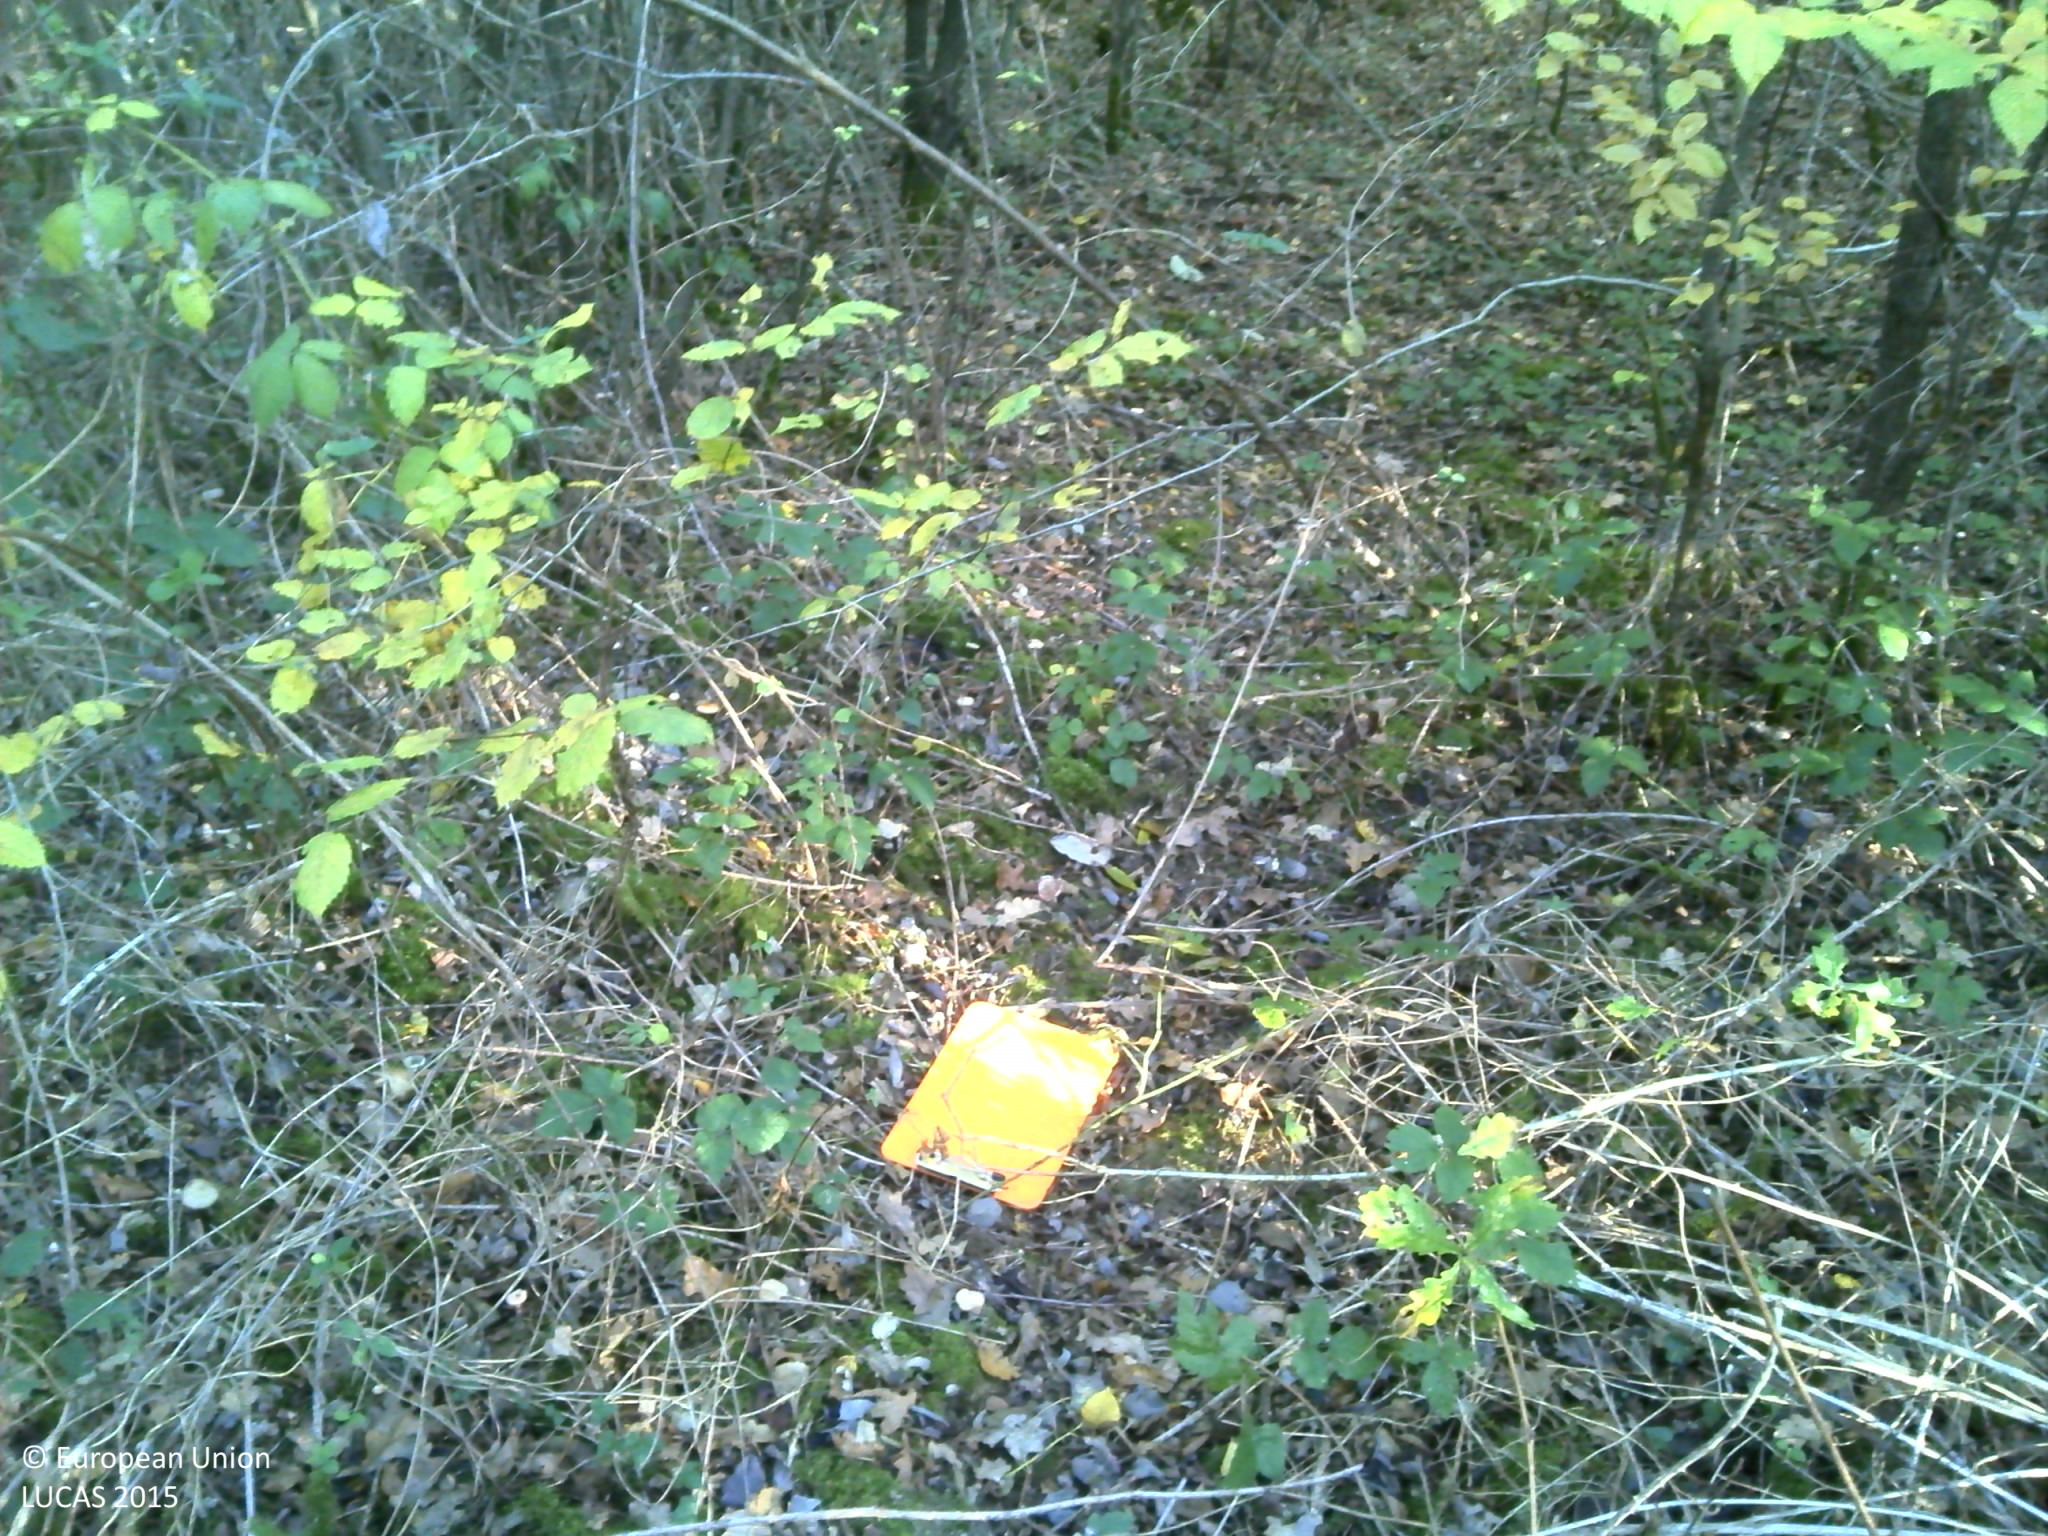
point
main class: Woodland
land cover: Broadleaved woodland
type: mesophytic deciduous forest
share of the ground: > 75 %
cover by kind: broadleaved forest trees 100 %
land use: Forestry
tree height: > 5 m
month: October
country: FR
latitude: 47.1877
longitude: 5.3425
